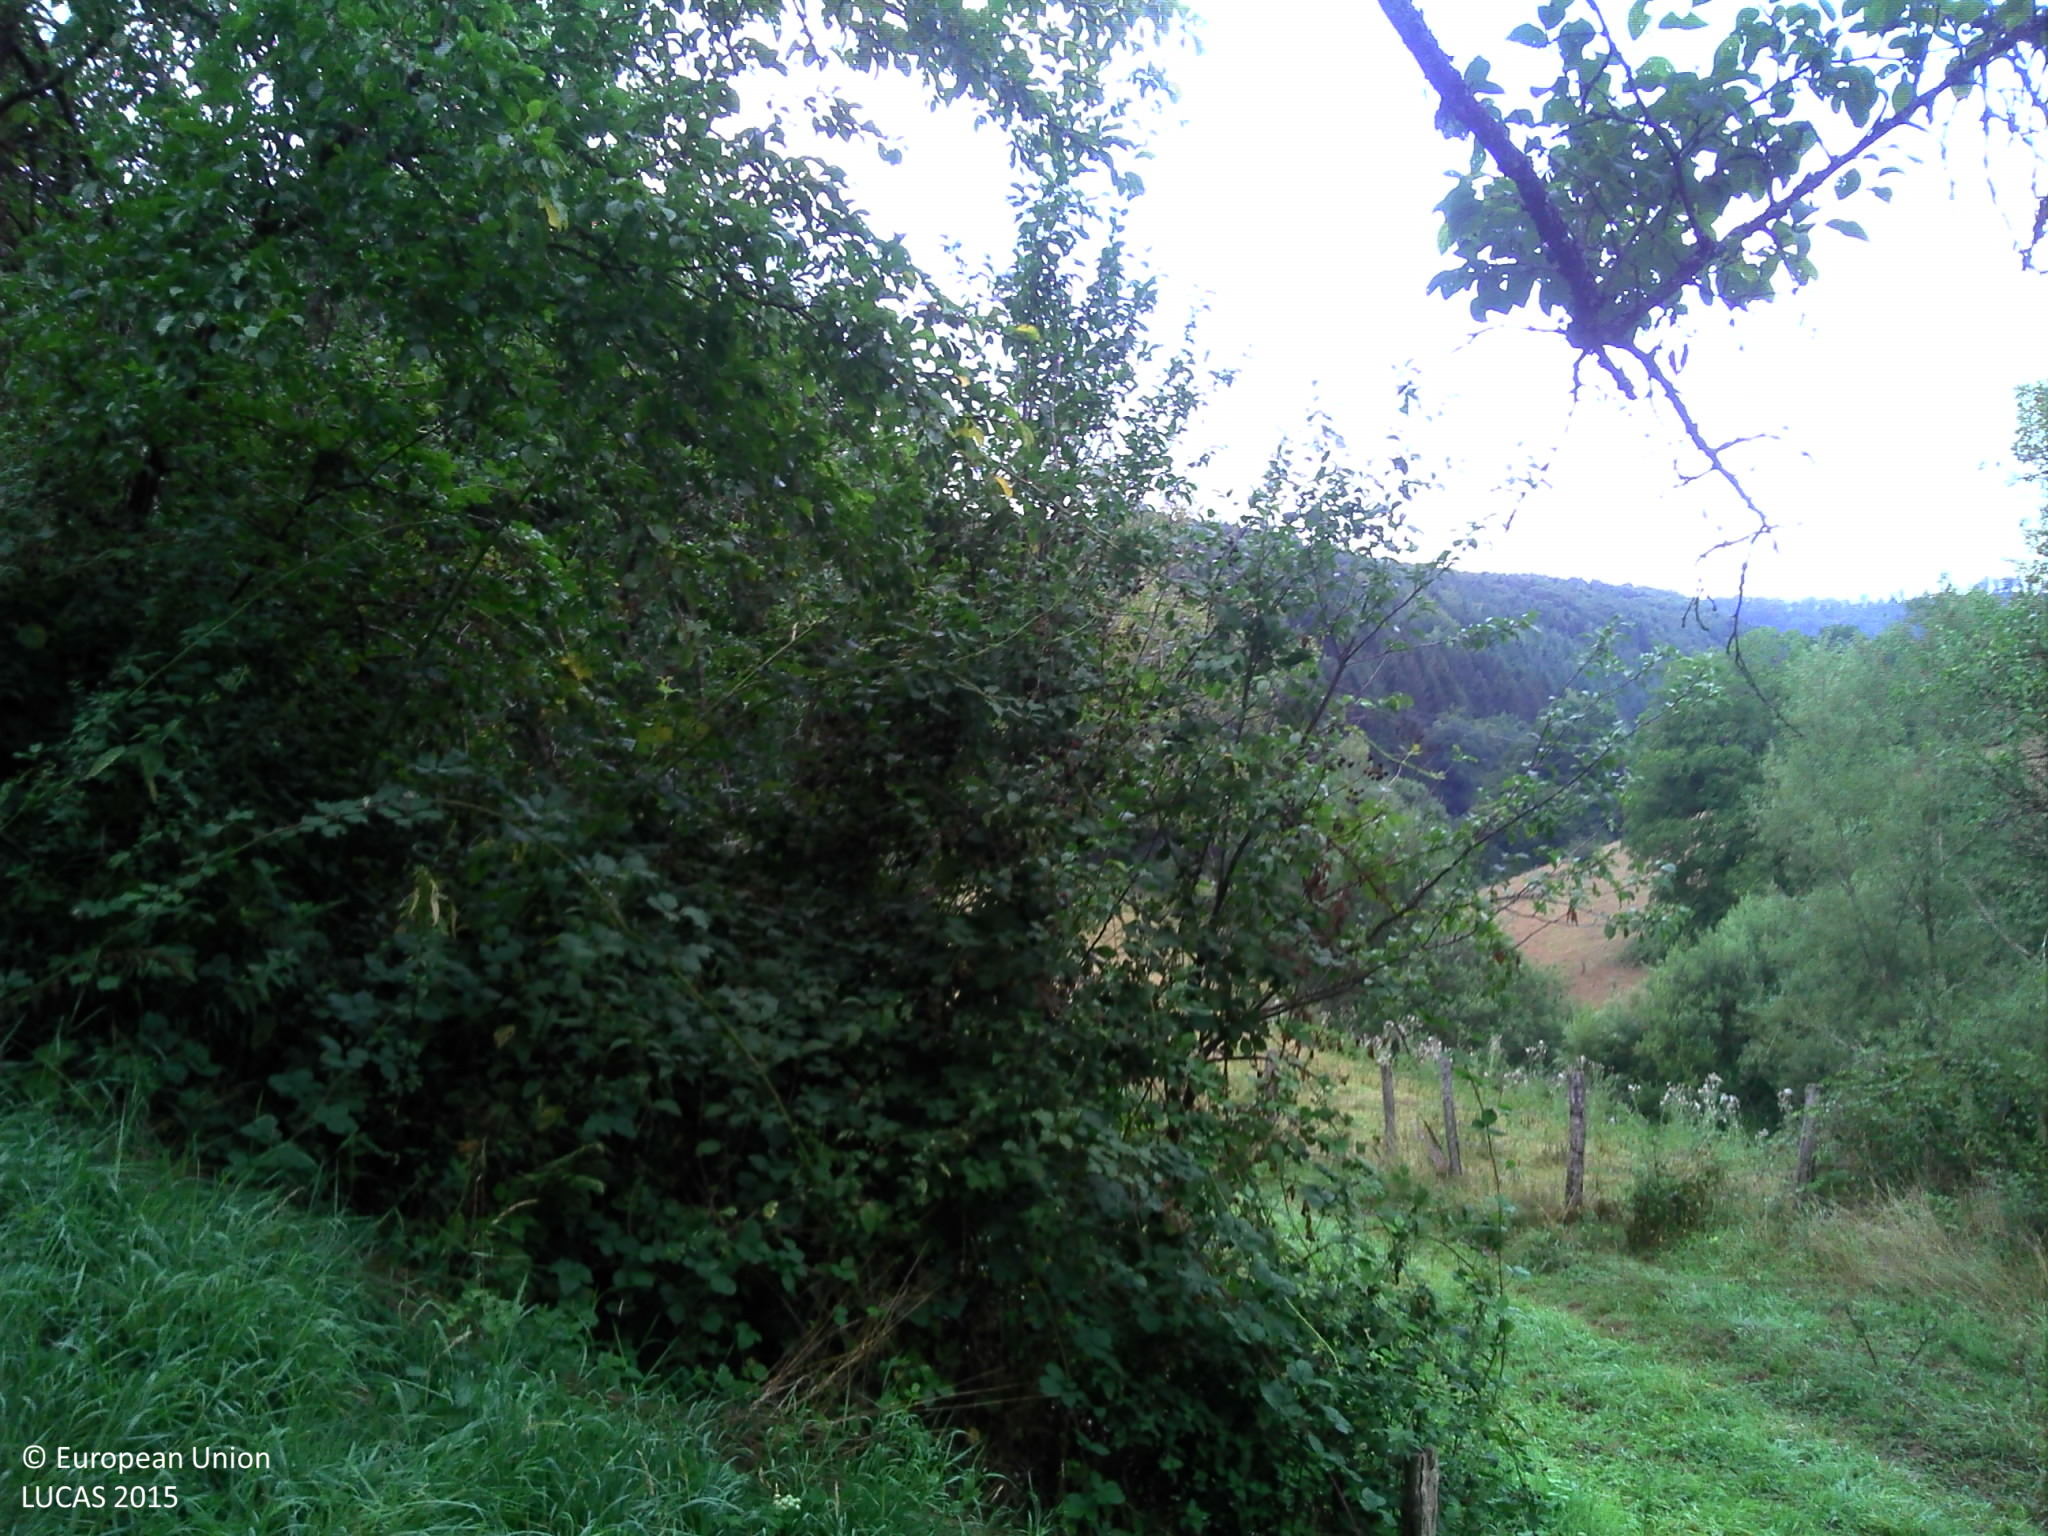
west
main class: Grassland
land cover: Grassland with sparse tree/shrub cover
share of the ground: > 75 %
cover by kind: herbaceous plants 95 %, broadleaved forest trees 5 %
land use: Agriculture (excluding fallow land and kitchen gardens)
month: August
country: FR
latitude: 48.9109
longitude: 7.3126
